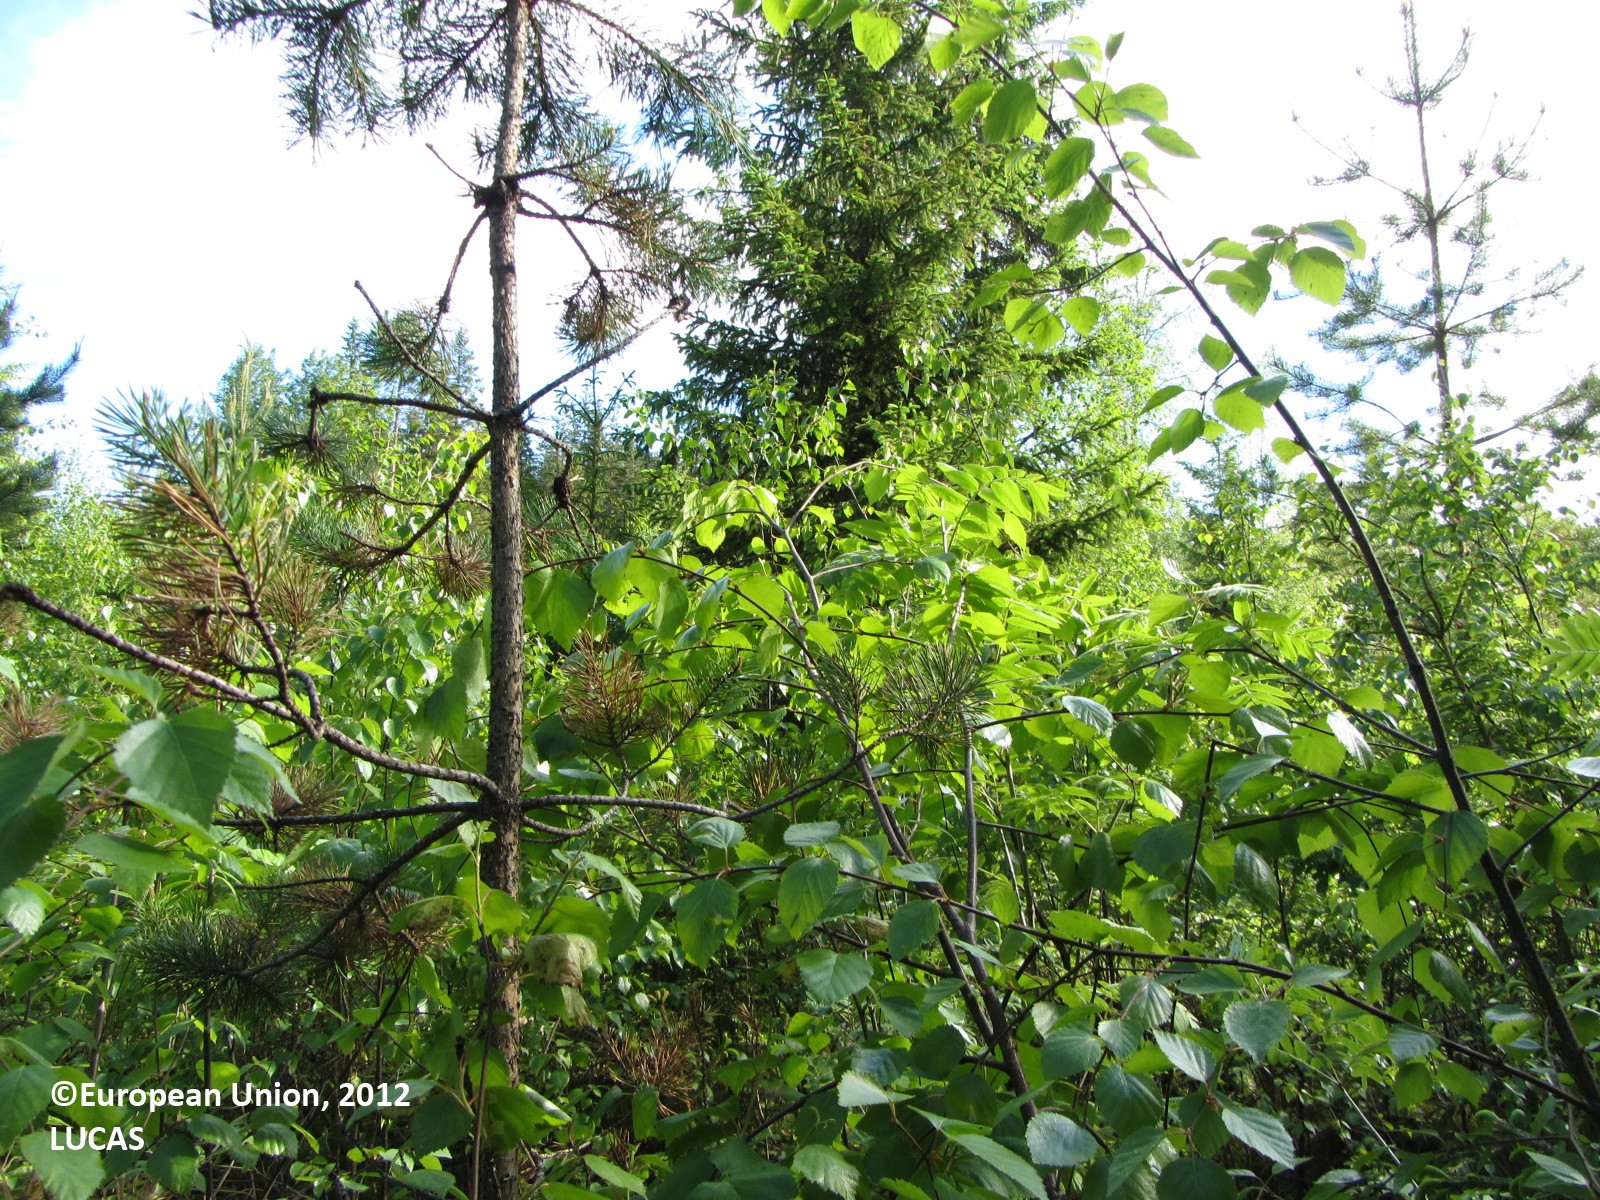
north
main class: Woodland
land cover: Broadleaved woodland
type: hemiboreal forest and nemoral coniferous forest and mixed broadleaved-coniferous forest
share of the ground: > 75 %
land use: Forestry
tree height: > 5 m
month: June
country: FI
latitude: 61.9288
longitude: 24.6323
